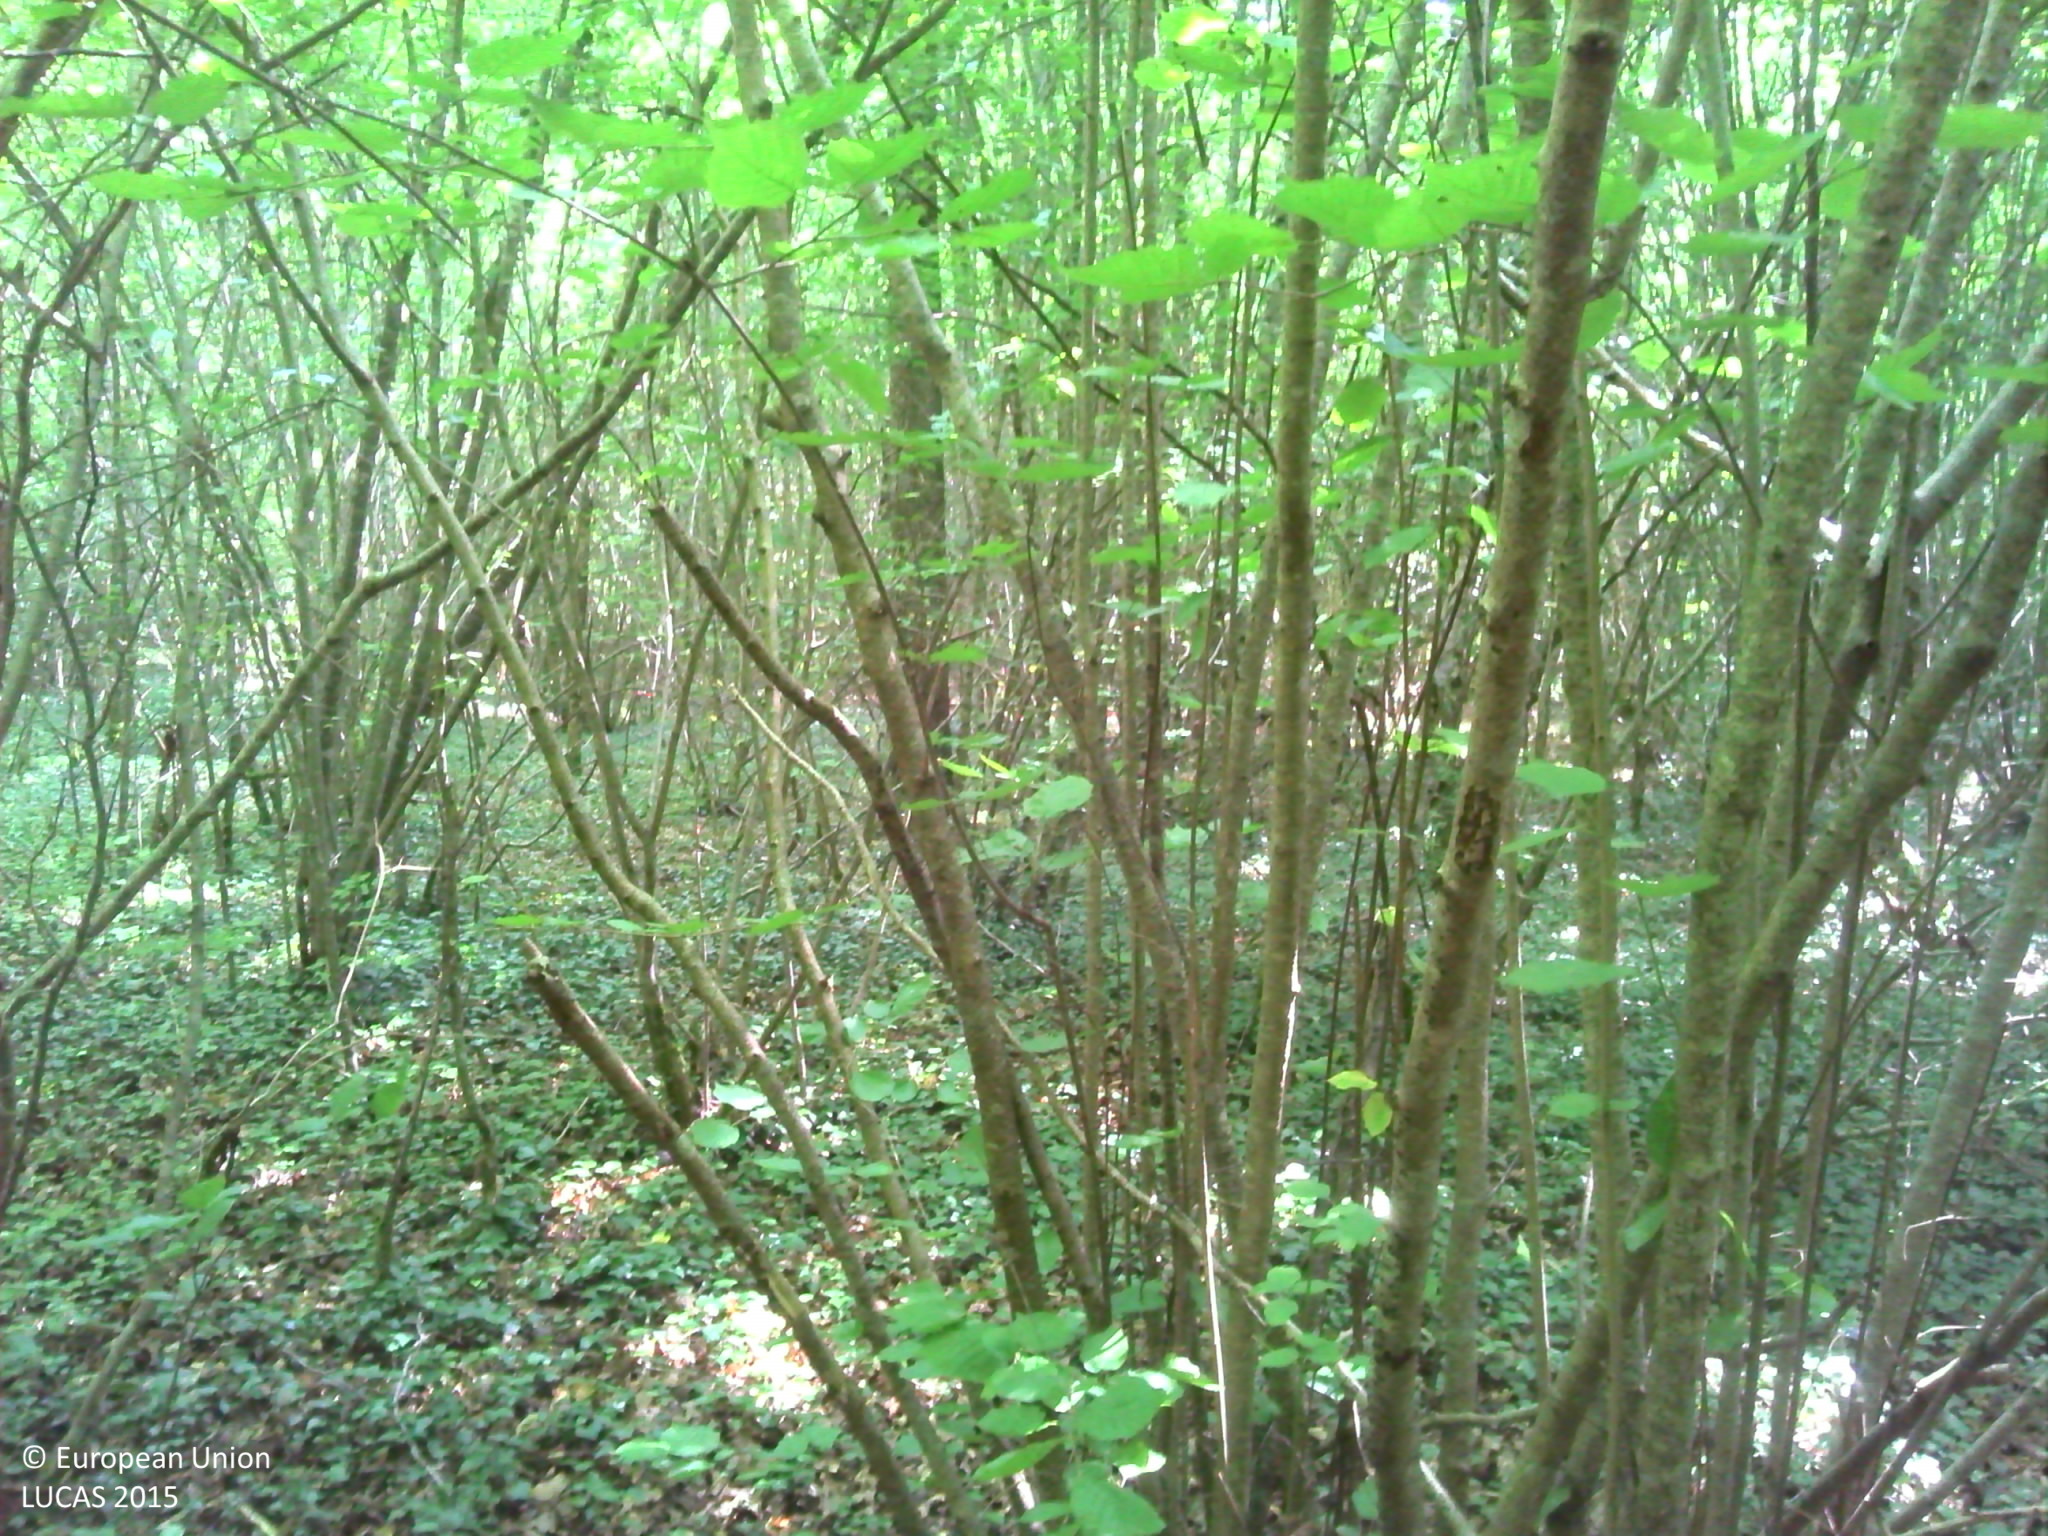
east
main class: Woodland
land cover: Broadleaved woodland
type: mesophytic deciduous forest
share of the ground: > 75 %
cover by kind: broadleaved forest trees 90 %, herbaceous plants 5 %, lichens and mosses 5 %
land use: Forestry
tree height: > 5 m
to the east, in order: Broadleaved woodland; Ditches and canals; Broadleaved woodland; Rape and turnip rape
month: July
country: FR
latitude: 47.6385
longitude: 3.5673
